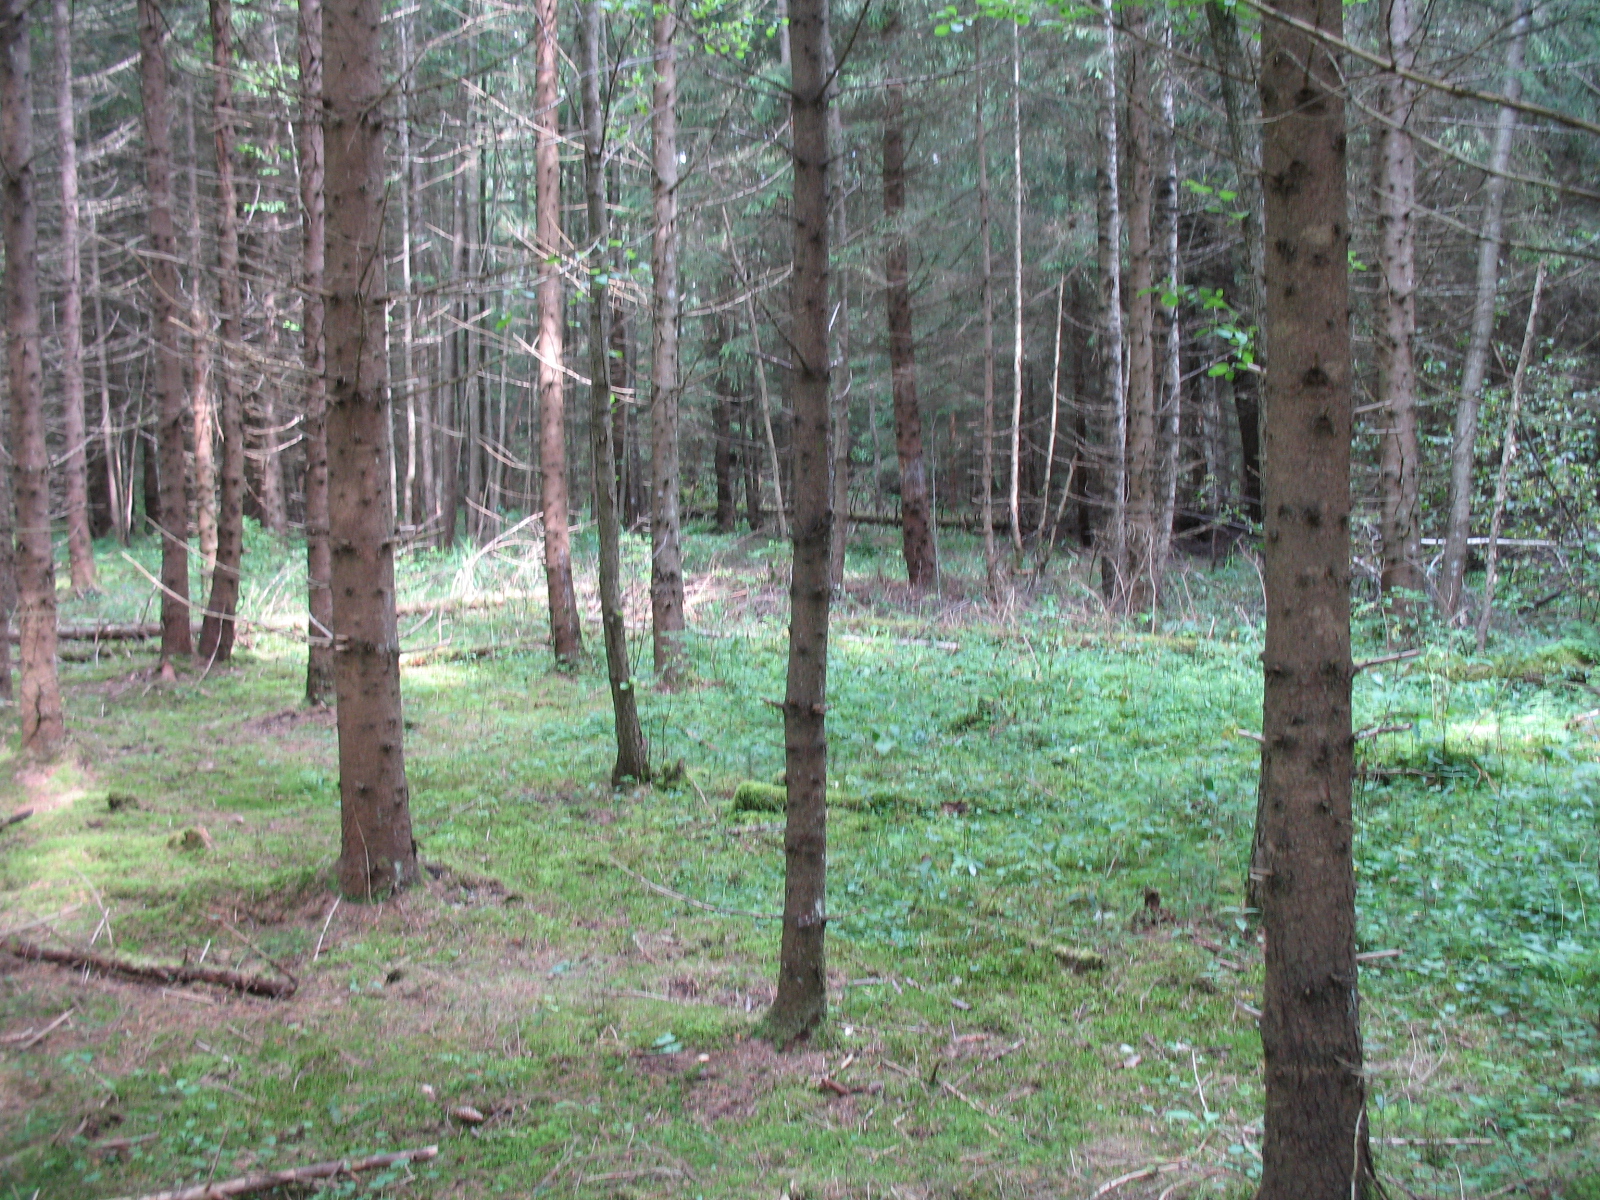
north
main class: Woodland
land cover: Spruce dominated coniferous woodland
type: hemiboreal forest and nemoral coniferous forest and mixed broadleaved-coniferous forest
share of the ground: > 75 %
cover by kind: coniferous forest trees 70 %, herbaceous plants 15 %, lichens and mosses 10 %, broadleaved forest trees 5 %
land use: Forestry
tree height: > 5 m
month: July
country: LV
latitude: 56.3875
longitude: 25.0930
